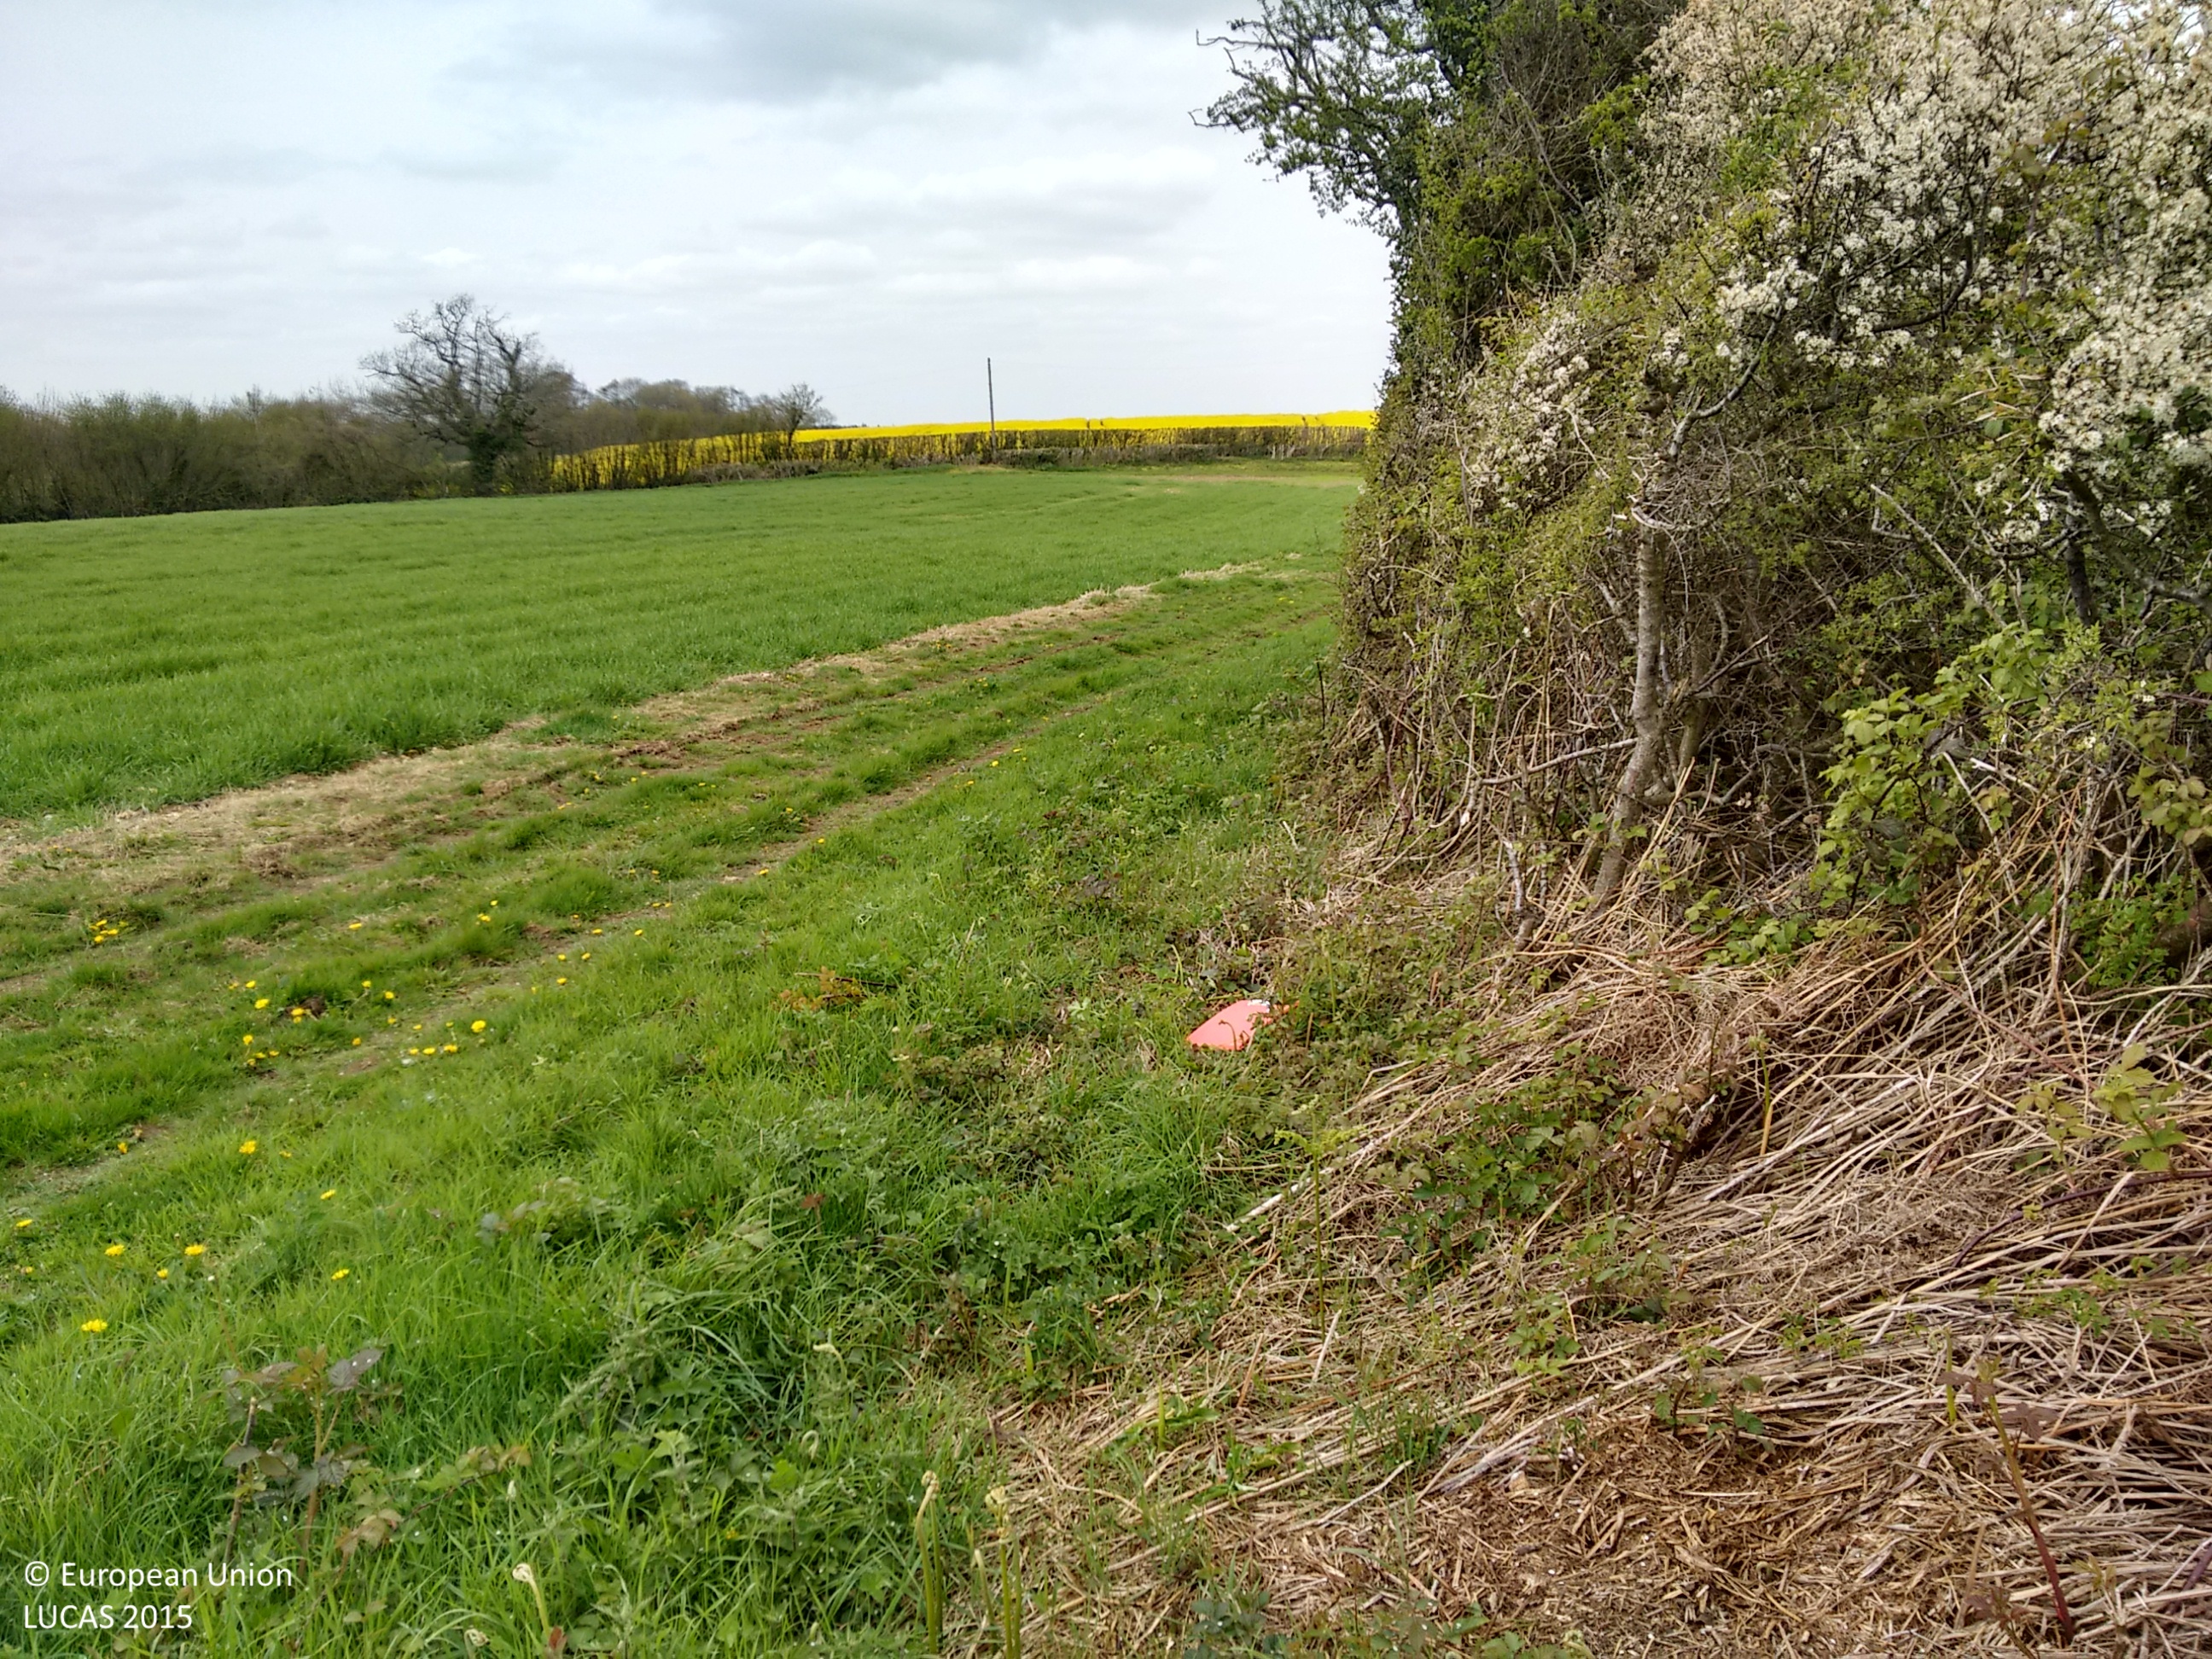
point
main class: Shrubland
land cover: Shrubland with sparse tree cover
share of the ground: > 75 %
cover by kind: shrubs 95 %, broadleaved forest trees 5 %
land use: Agriculture (excluding fallow land and kitchen gardens)
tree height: < 5 m
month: May
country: GB
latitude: 51.0697
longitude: -0.9613
